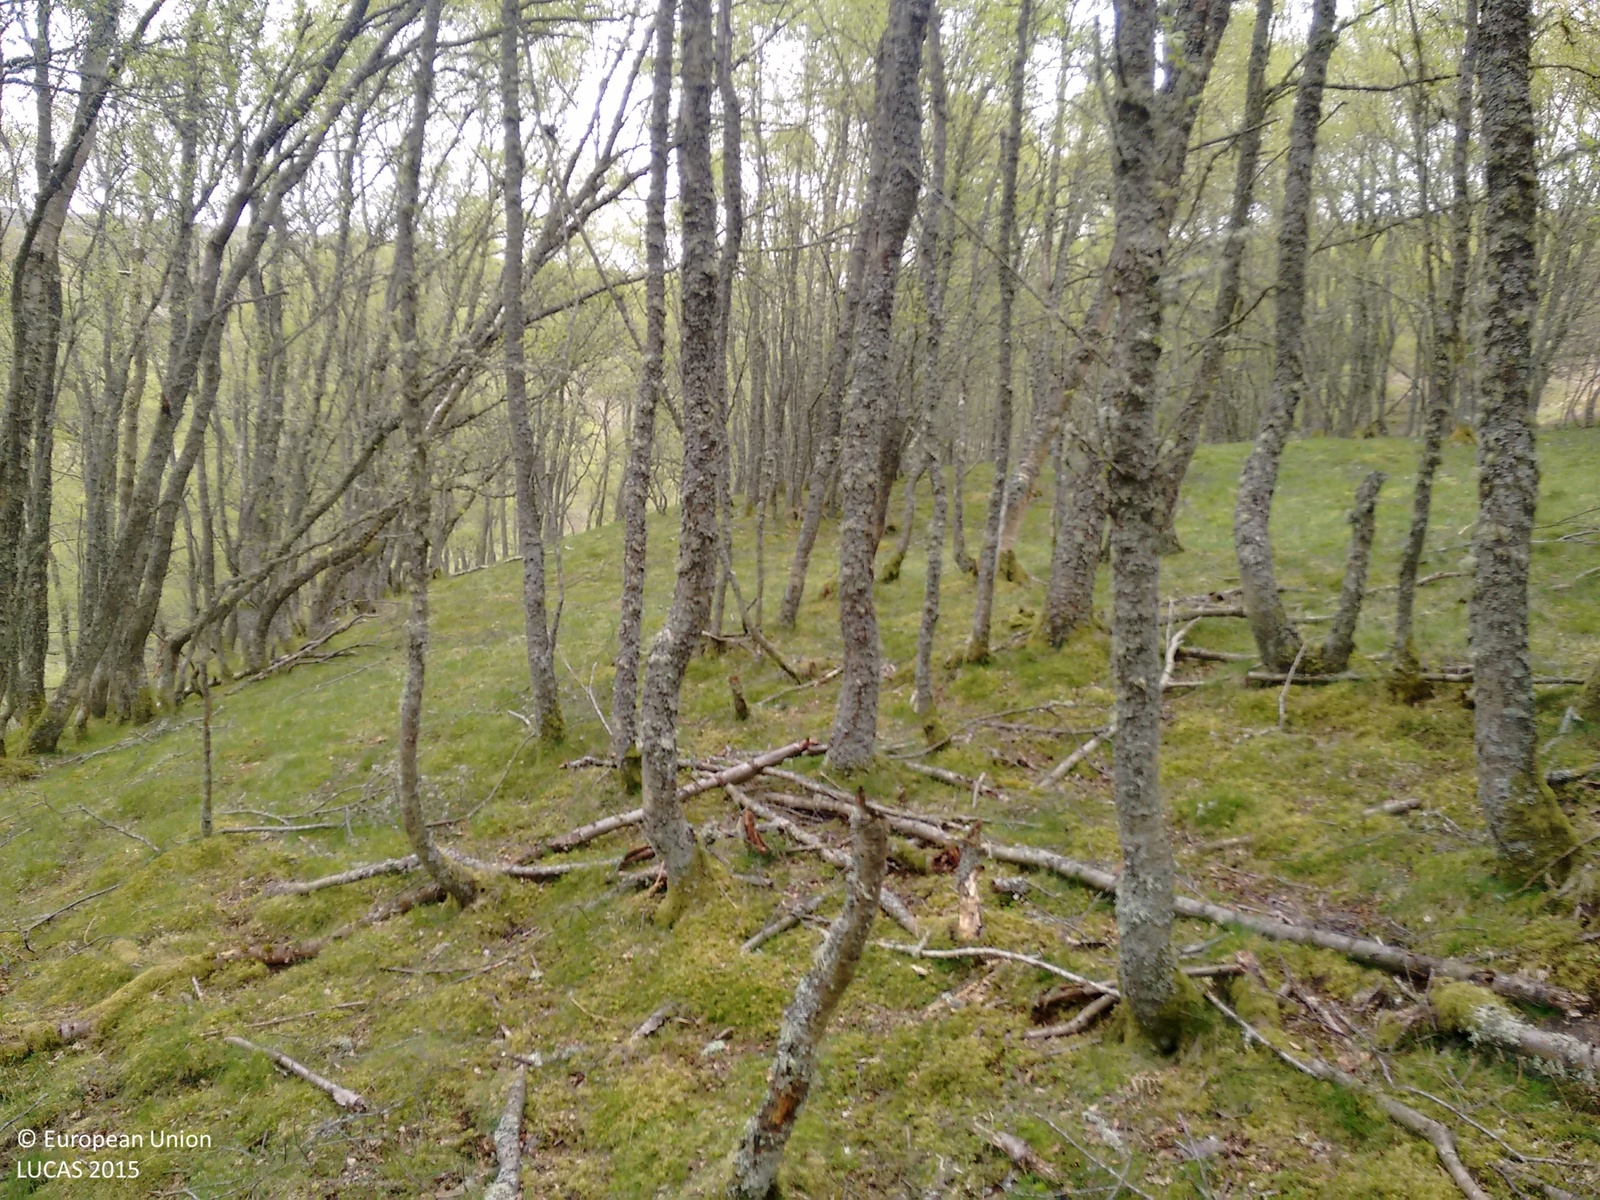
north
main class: Woodland
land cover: Broadleaved woodland
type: non-riverine alder, birch or aspen forest
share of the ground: > 75 %
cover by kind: broadleaved forest trees 85 %, herbaceous plants 10 %, lichens and mosses 5 %
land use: Semi-natural and natural areas not in use
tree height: > 5 m
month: May
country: GB
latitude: 56.7145
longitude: -3.1209
